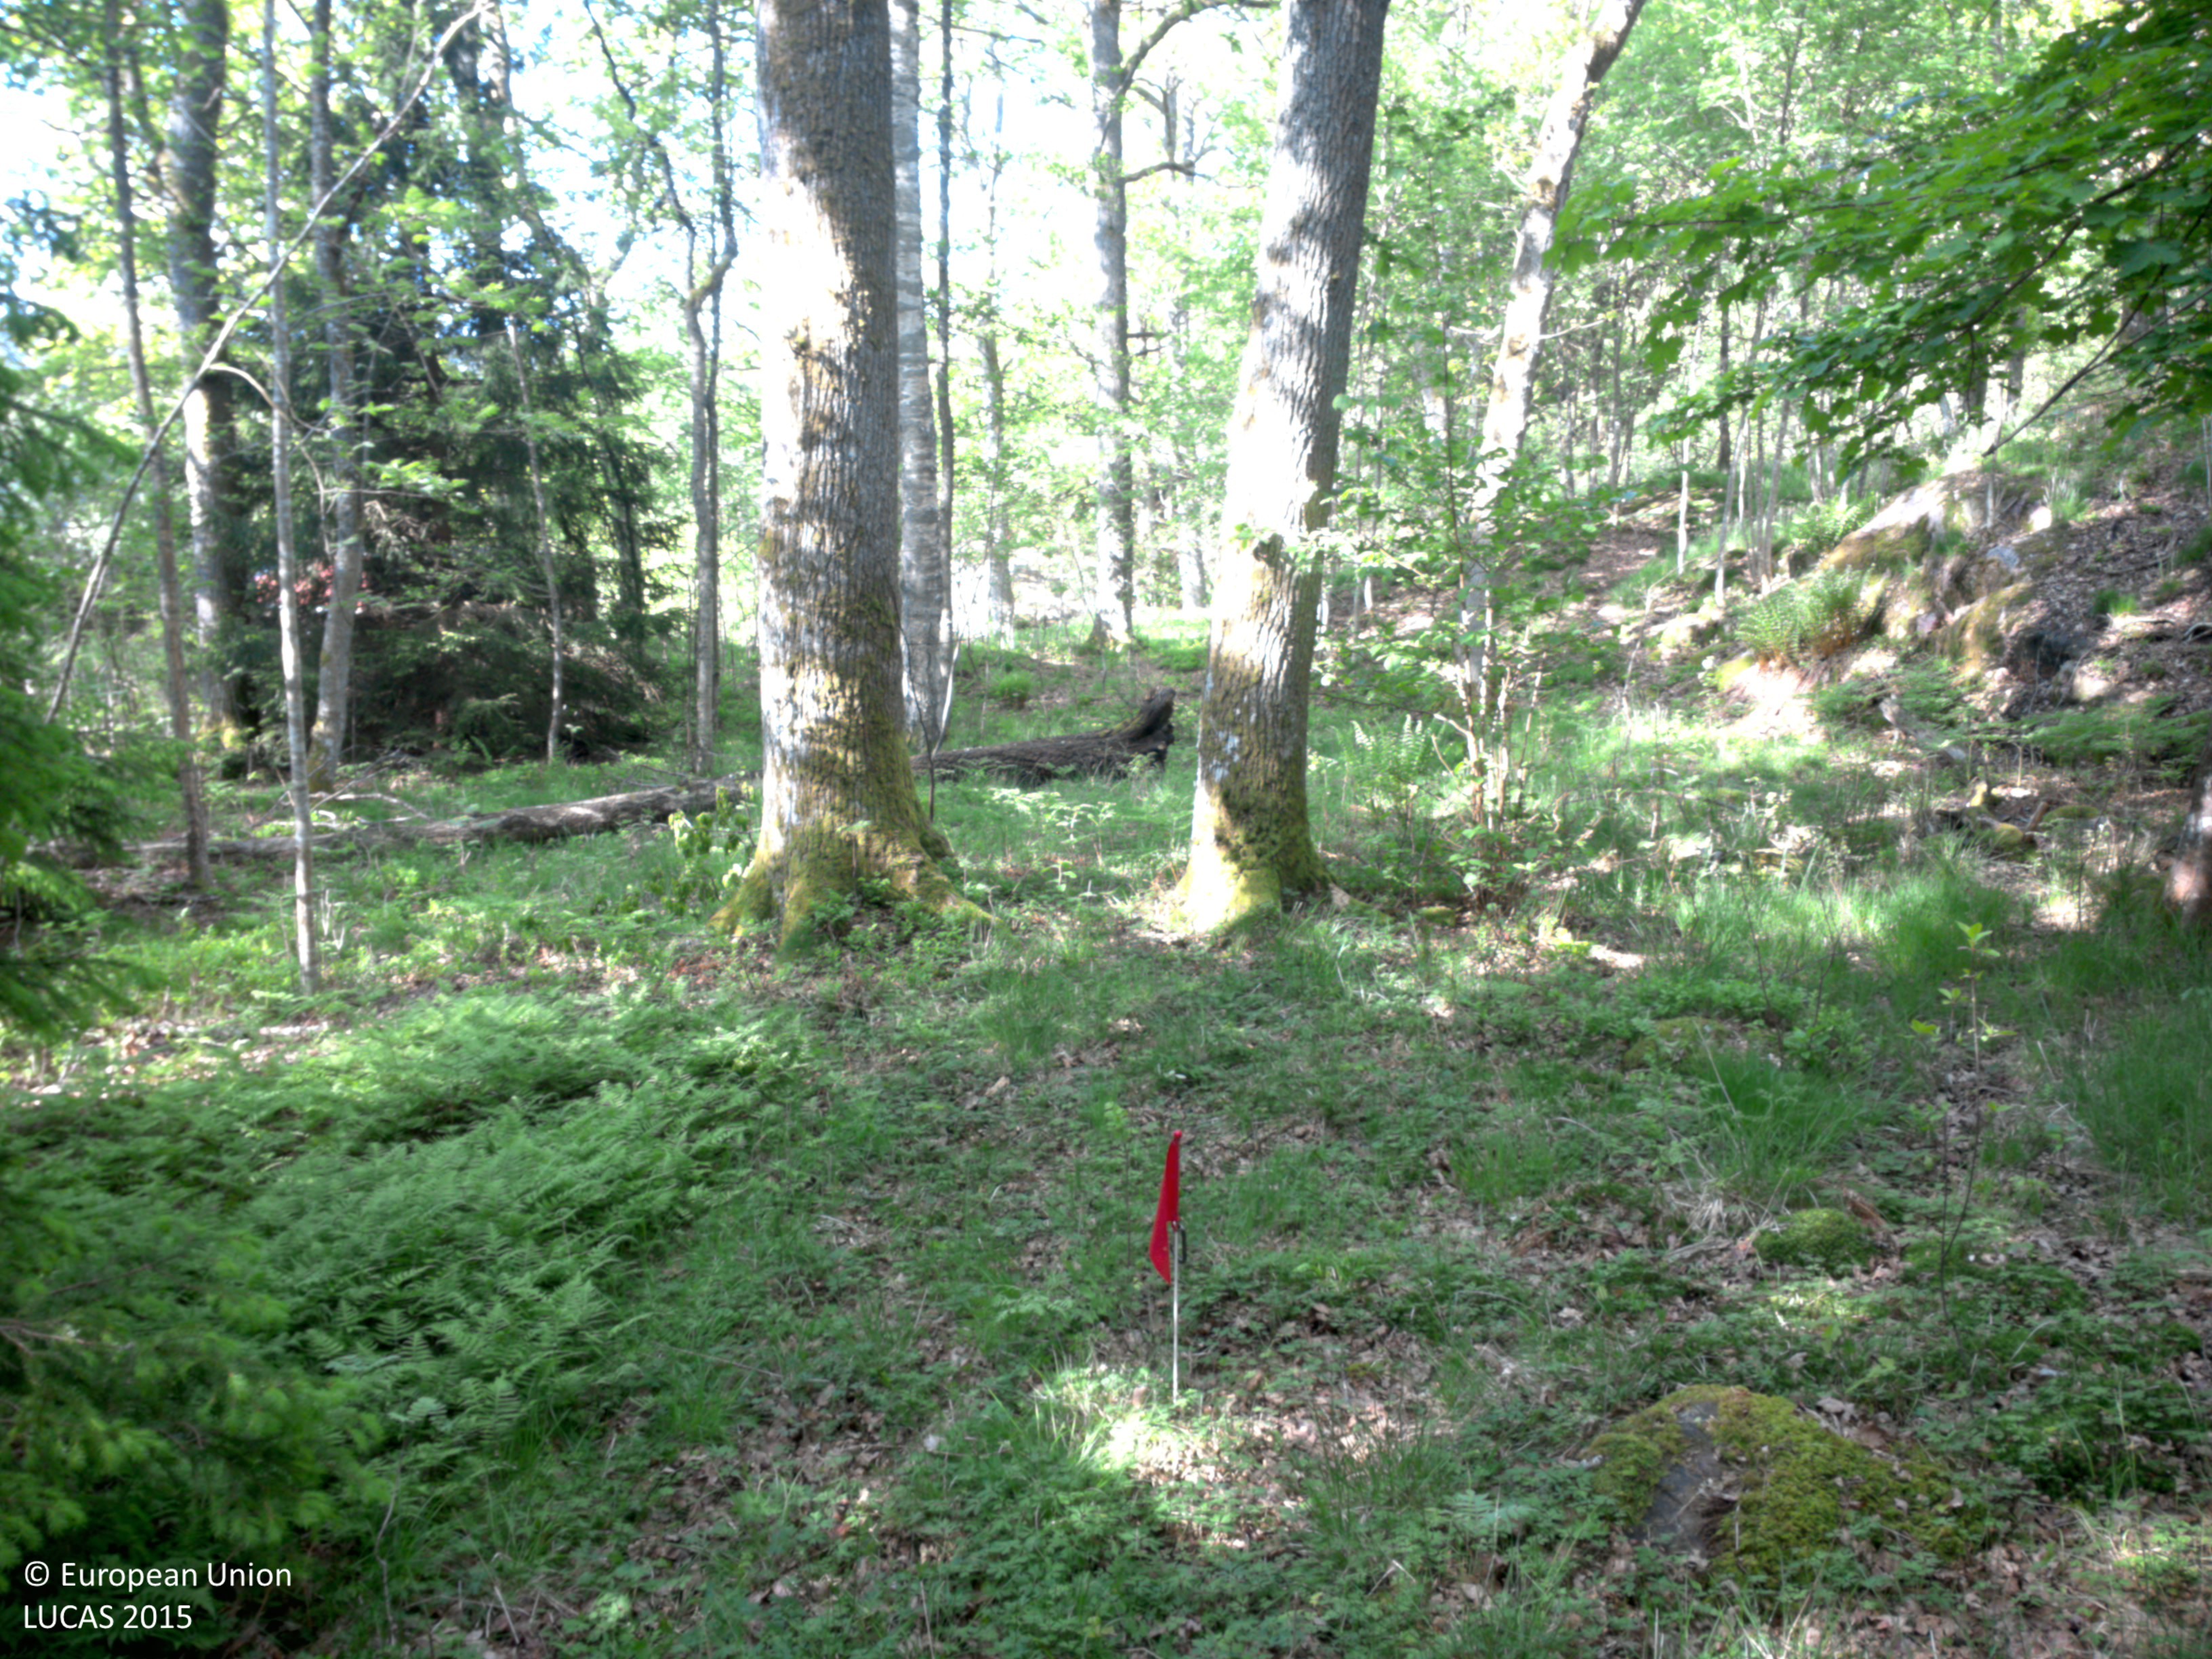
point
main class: Woodland
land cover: Broadleaved woodland
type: mesophytic deciduous forest
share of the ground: 50 - 75 %
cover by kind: broadleaved forest trees 65 %, herbaceous plants 30 %, coniferous forest trees 5 %
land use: Forestry
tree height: > 5 m
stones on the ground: 10 - 25 %
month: June
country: SE
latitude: 58.3506
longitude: 11.8587
